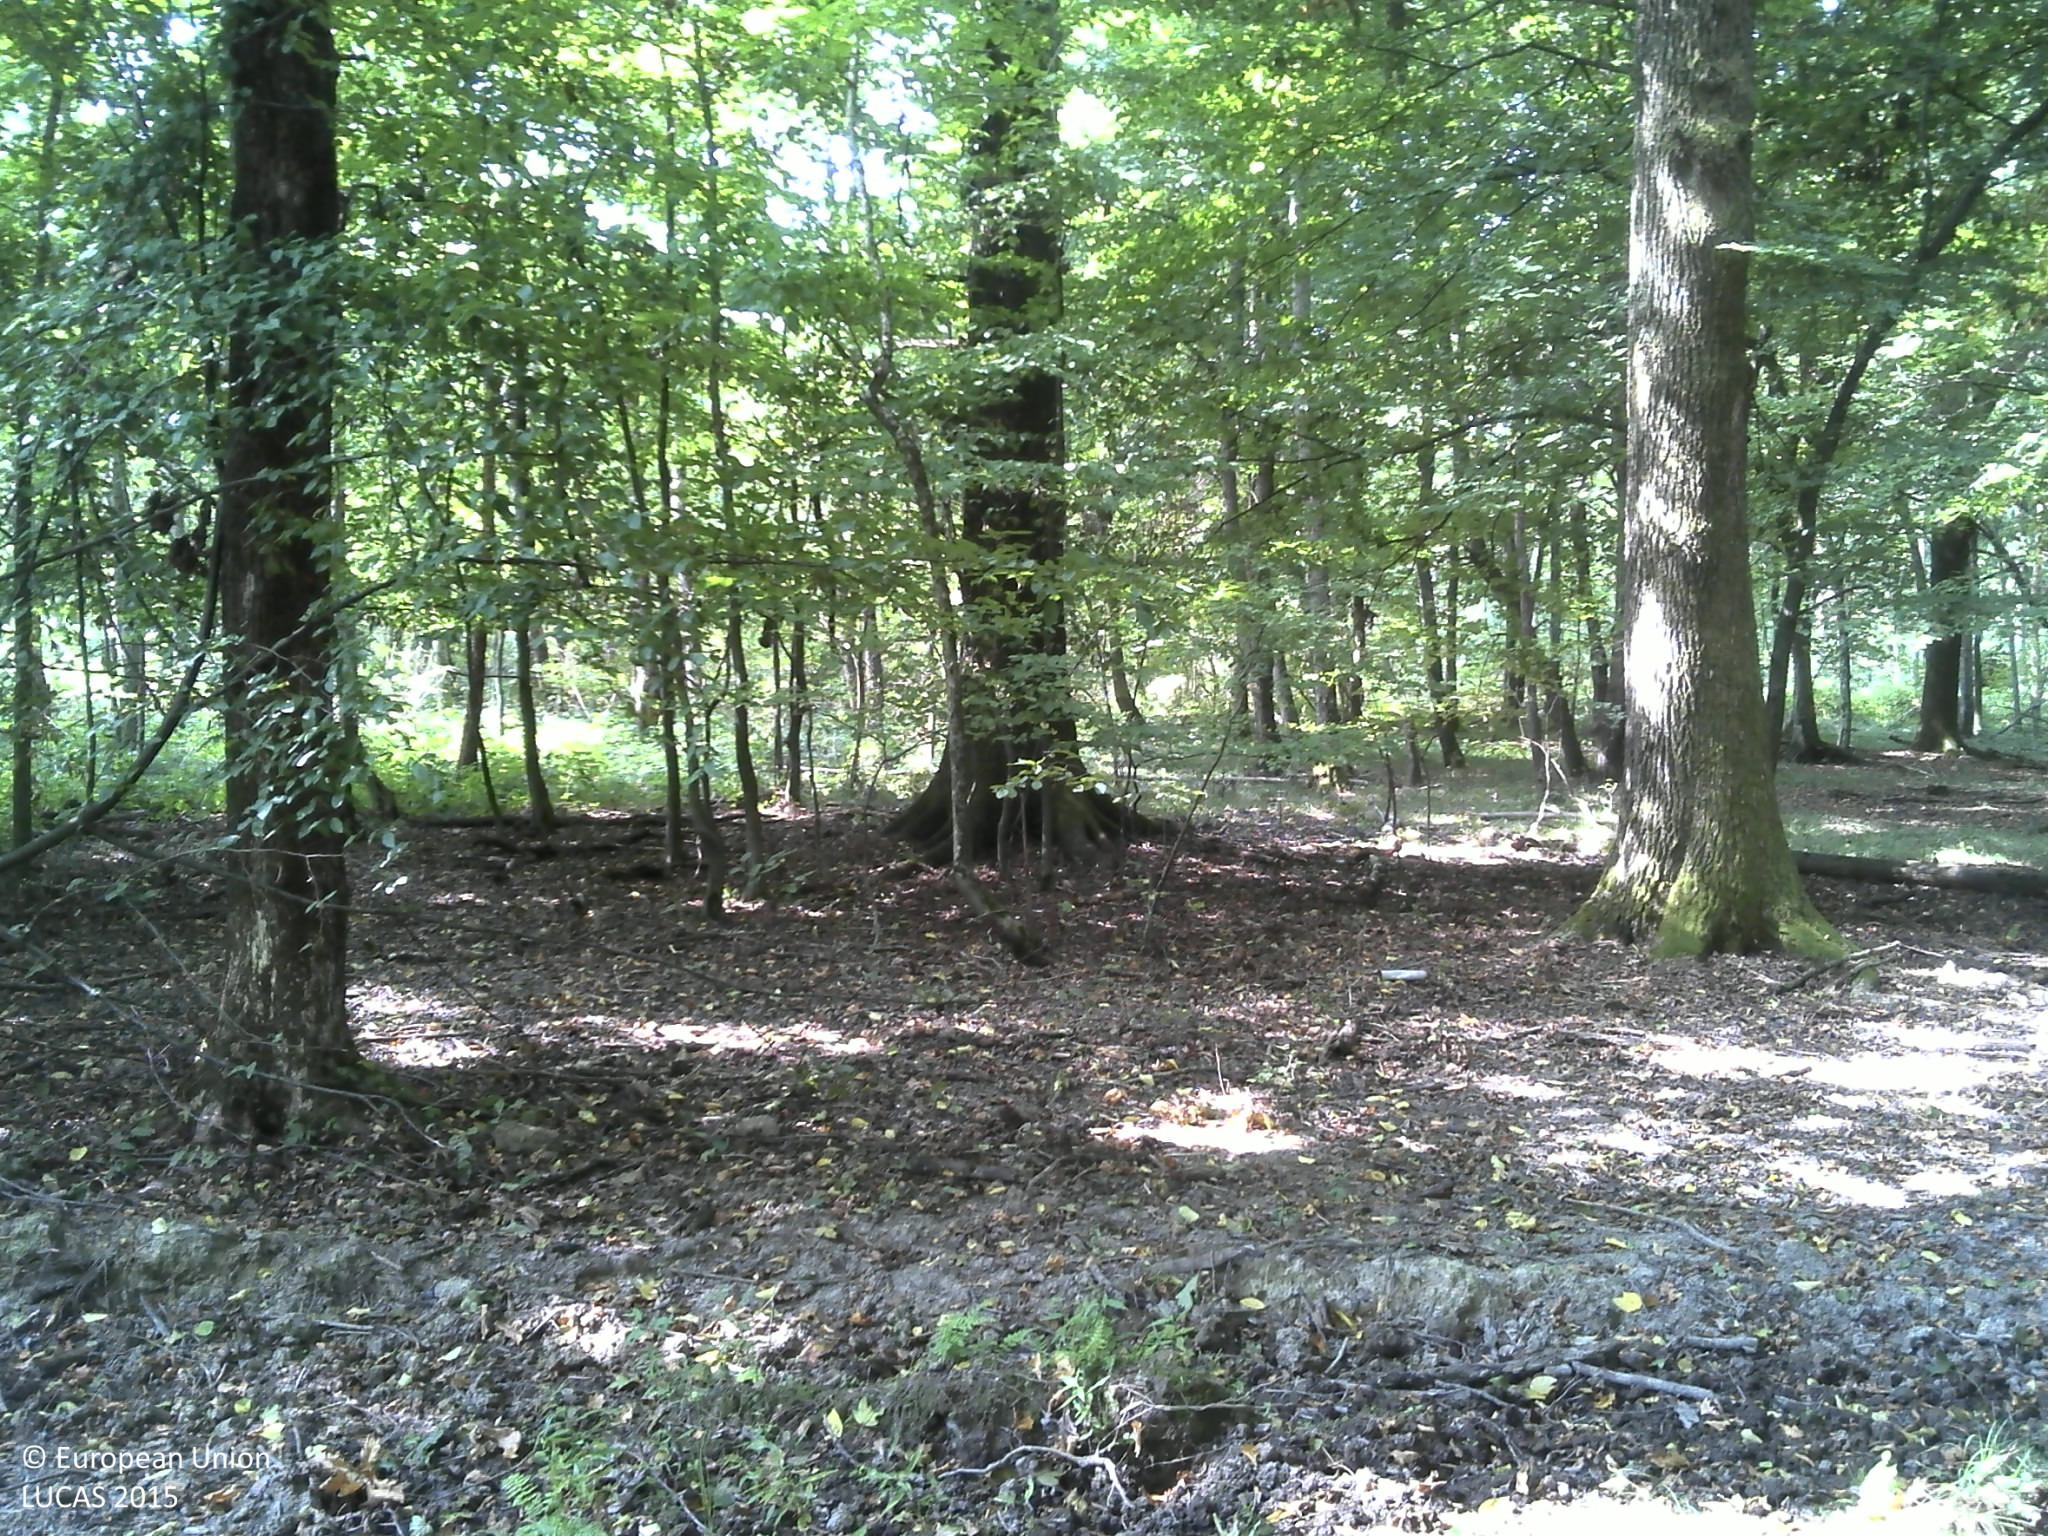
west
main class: Woodland
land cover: Broadleaved woodland
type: mesophytic deciduous forest
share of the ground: > 75 %
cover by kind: broadleaved forest trees 100 %
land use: Forestry
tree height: > 5 m
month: September
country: HR
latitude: 45.6963
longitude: 16.5872
